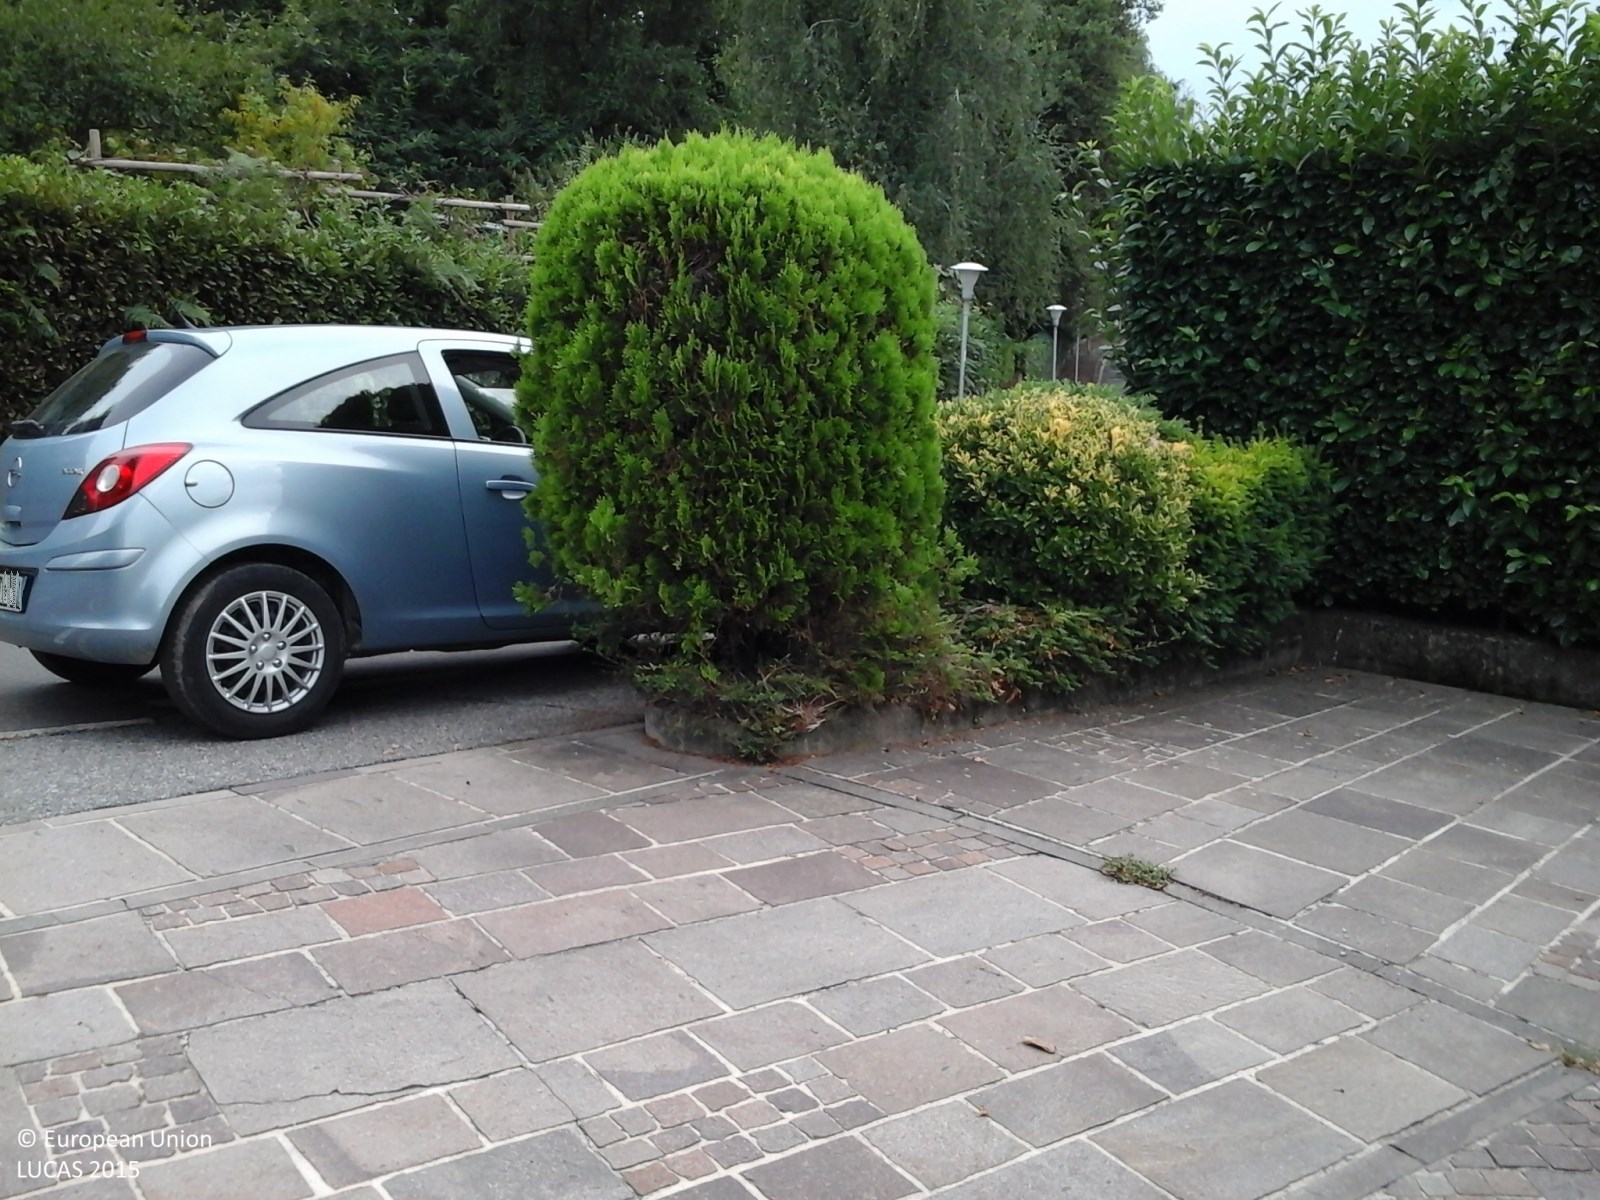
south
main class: Grassland
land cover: Grassland with sparse tree/shrub cover
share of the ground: > 75 %
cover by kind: herbaceous plants 85 %, shrubs 10 %, broadleaved forest trees 5 %
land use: Residential
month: August
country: IT
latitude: 45.7530
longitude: 9.1144
